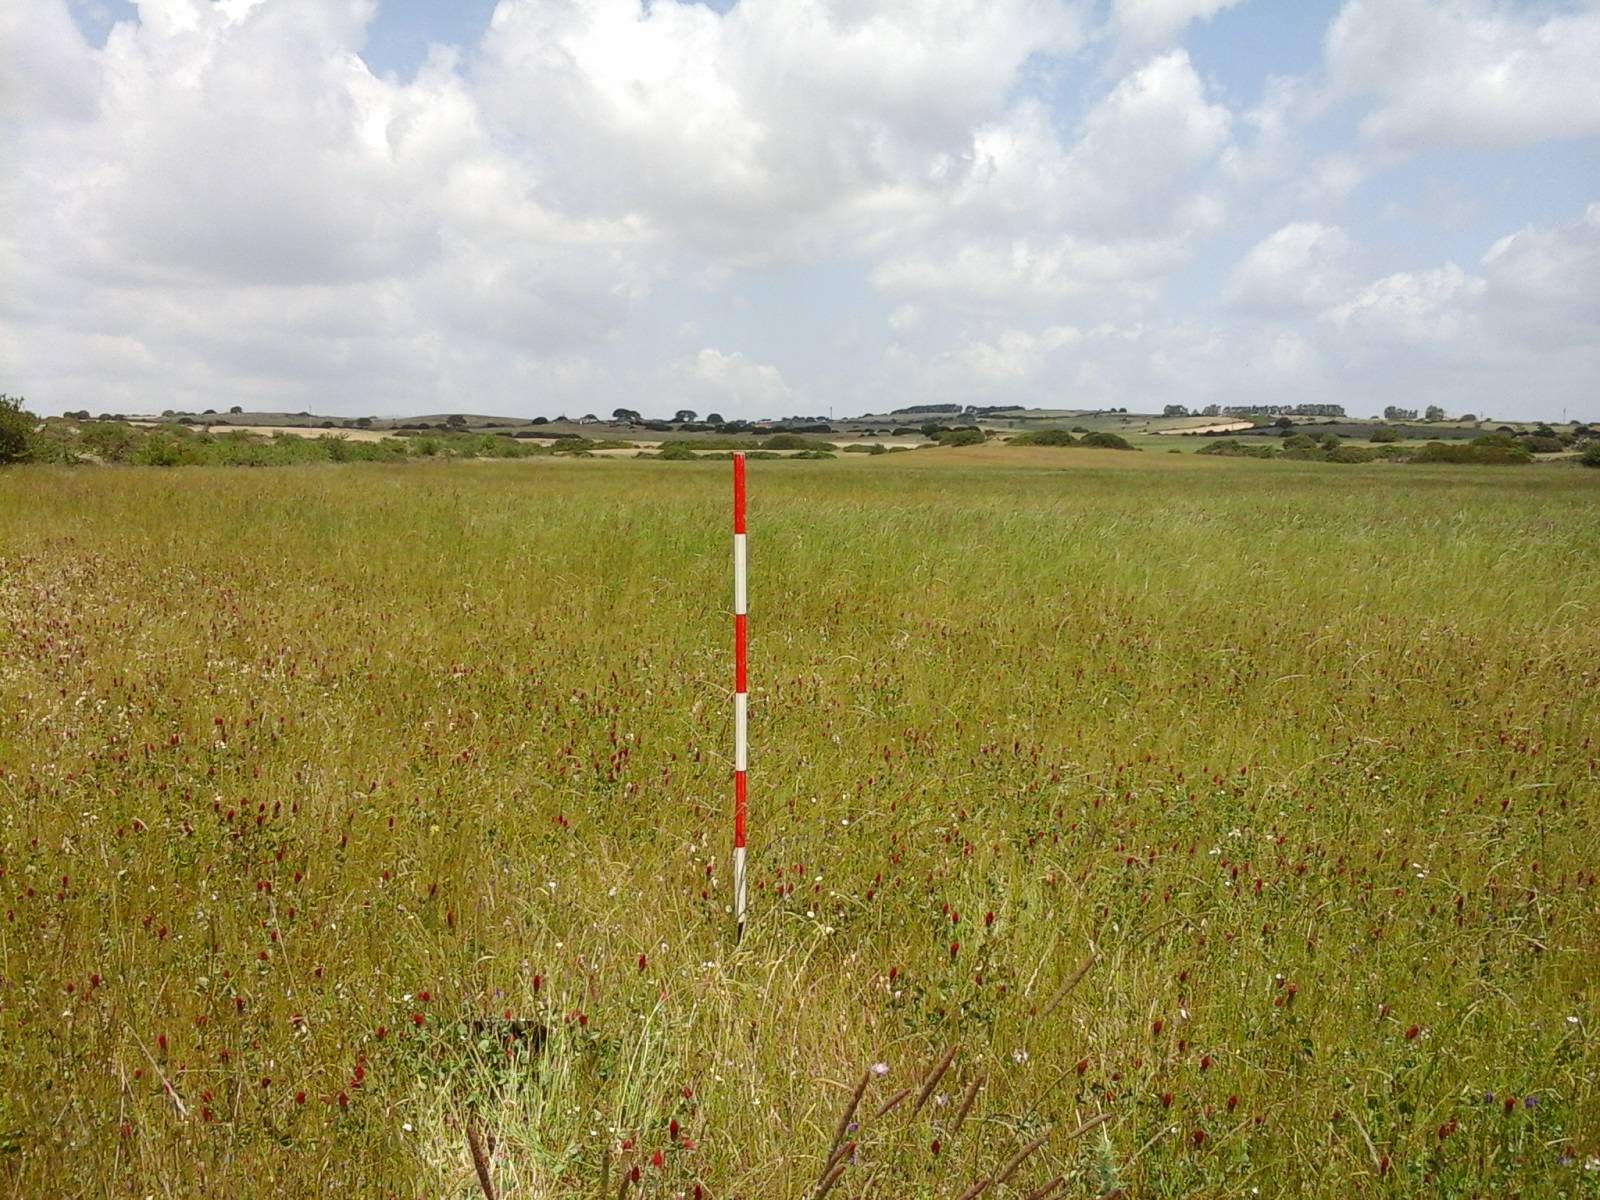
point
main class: Cropland
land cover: Other leguminous and mixtures for fodder
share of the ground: > 75 %
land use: Agriculture (excluding fallow land and kitchen gardens)
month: May
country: IT
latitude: 39.8265
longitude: 8.8963
